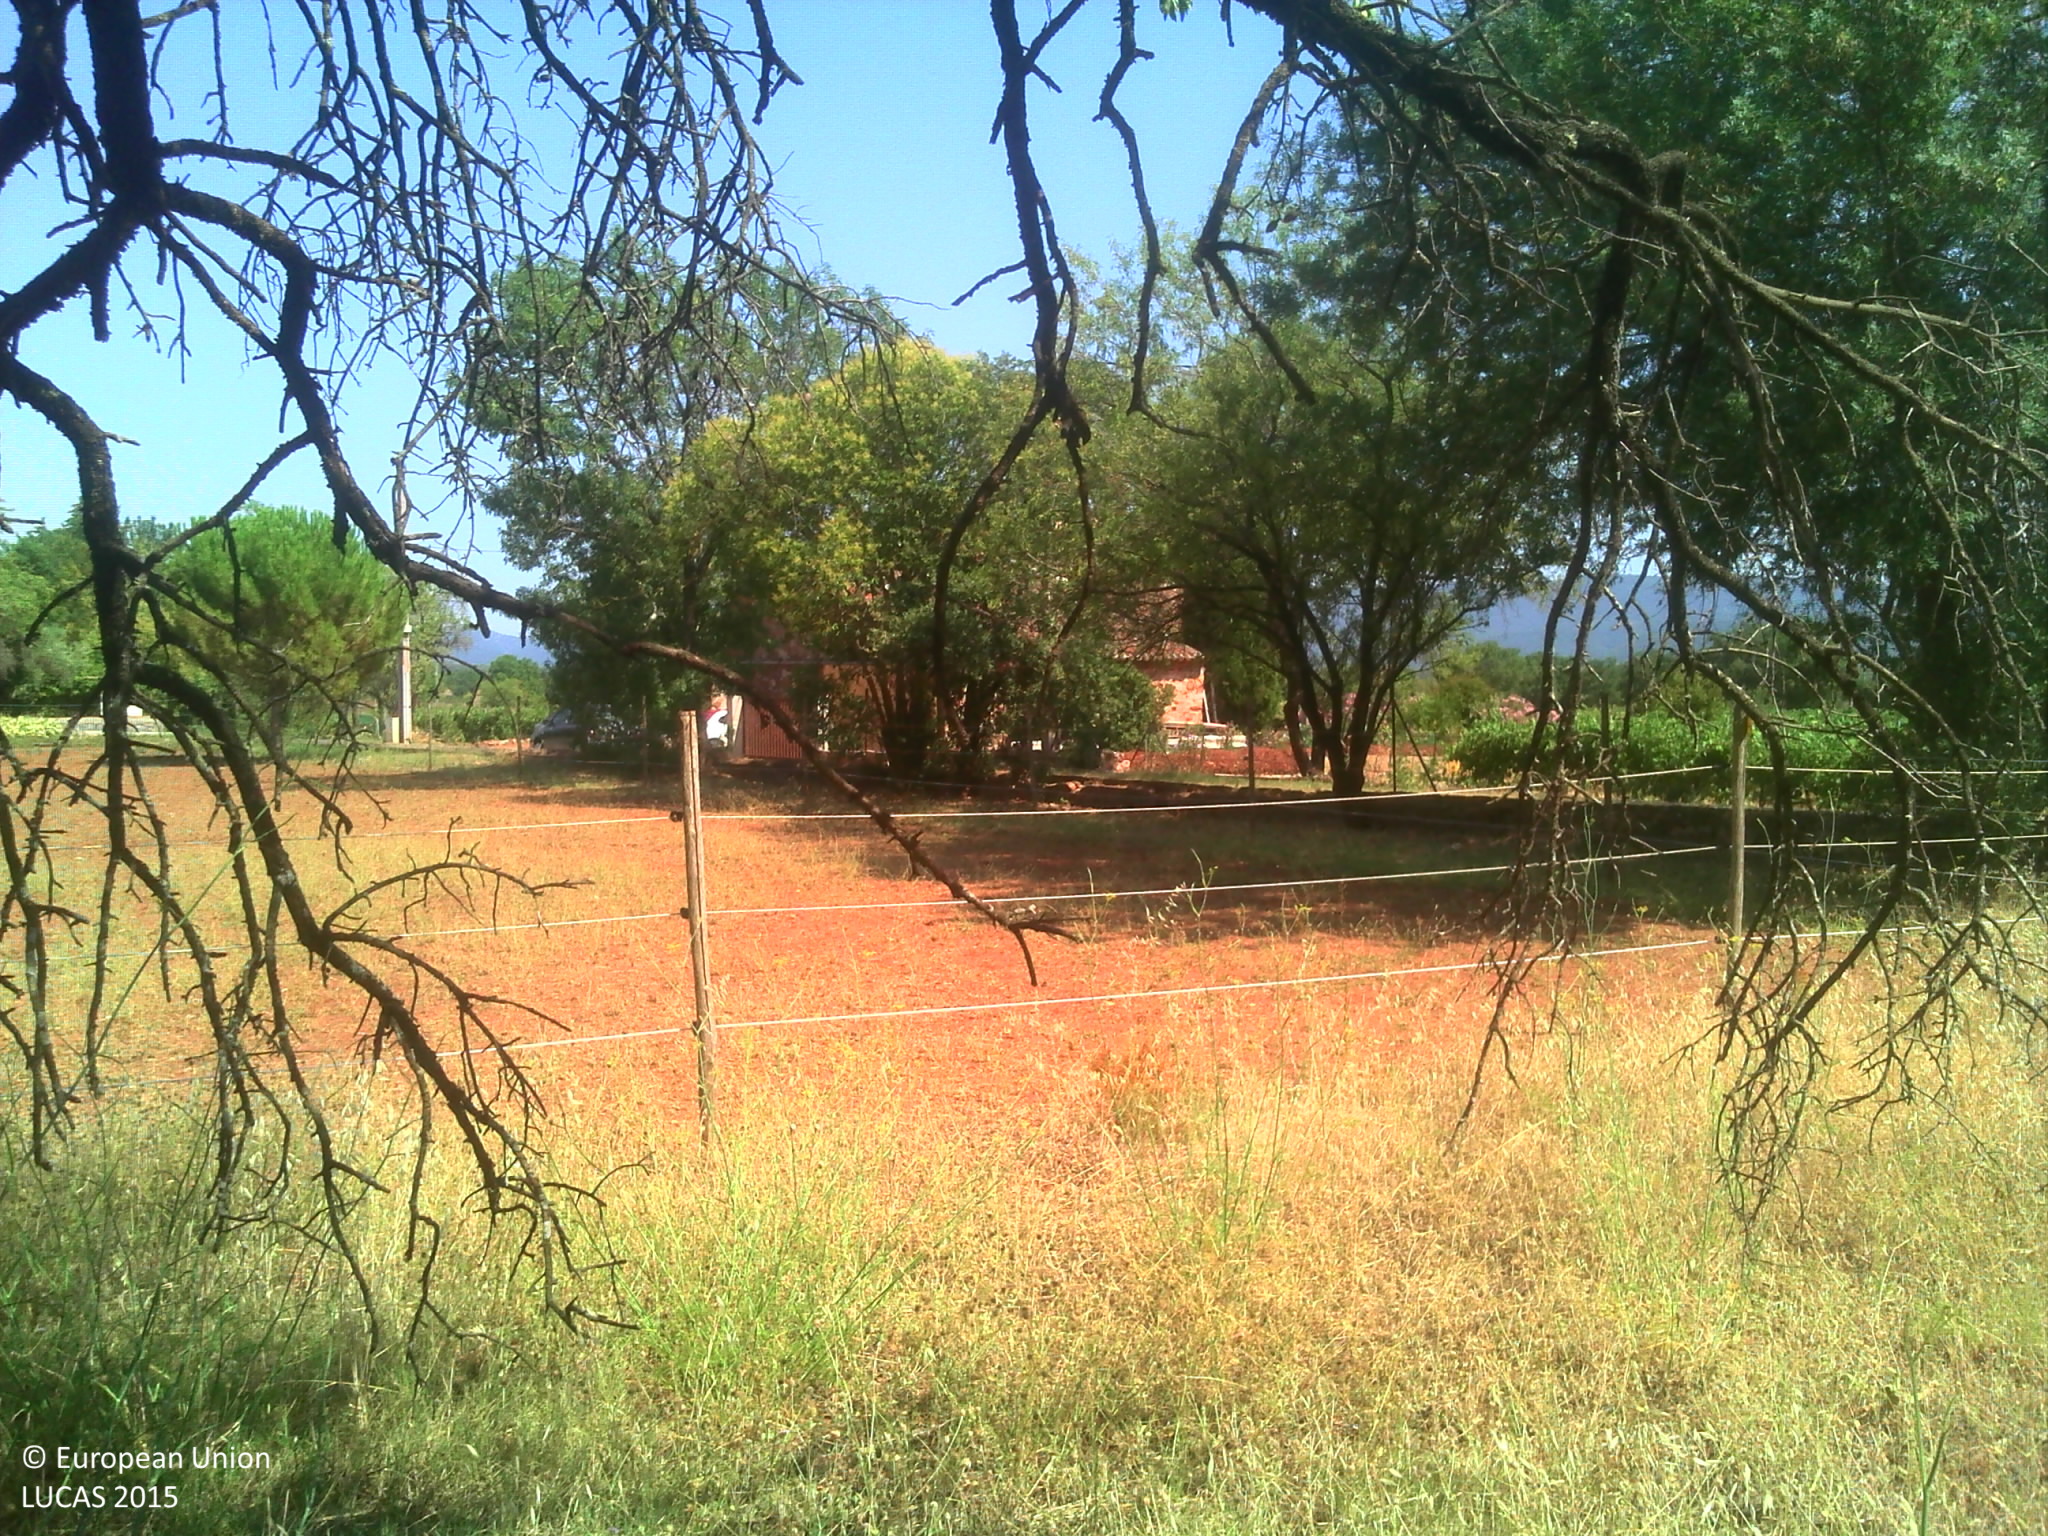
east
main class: Cropland
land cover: Nuts trees
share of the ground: < 10 %
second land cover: Grassland without tree/shrub cover
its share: > 75 %
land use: Kitchen garden
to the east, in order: Nuts trees; Grassland without tree/shrub cover; Fences; Other bare soil; Fences; Lines of trees; Artificial constructions in urban areas; Lines of trees; Fences; Grassland without tree/shrub cover; Vineyards
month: July
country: FR
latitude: 43.3634
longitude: 6.2949
